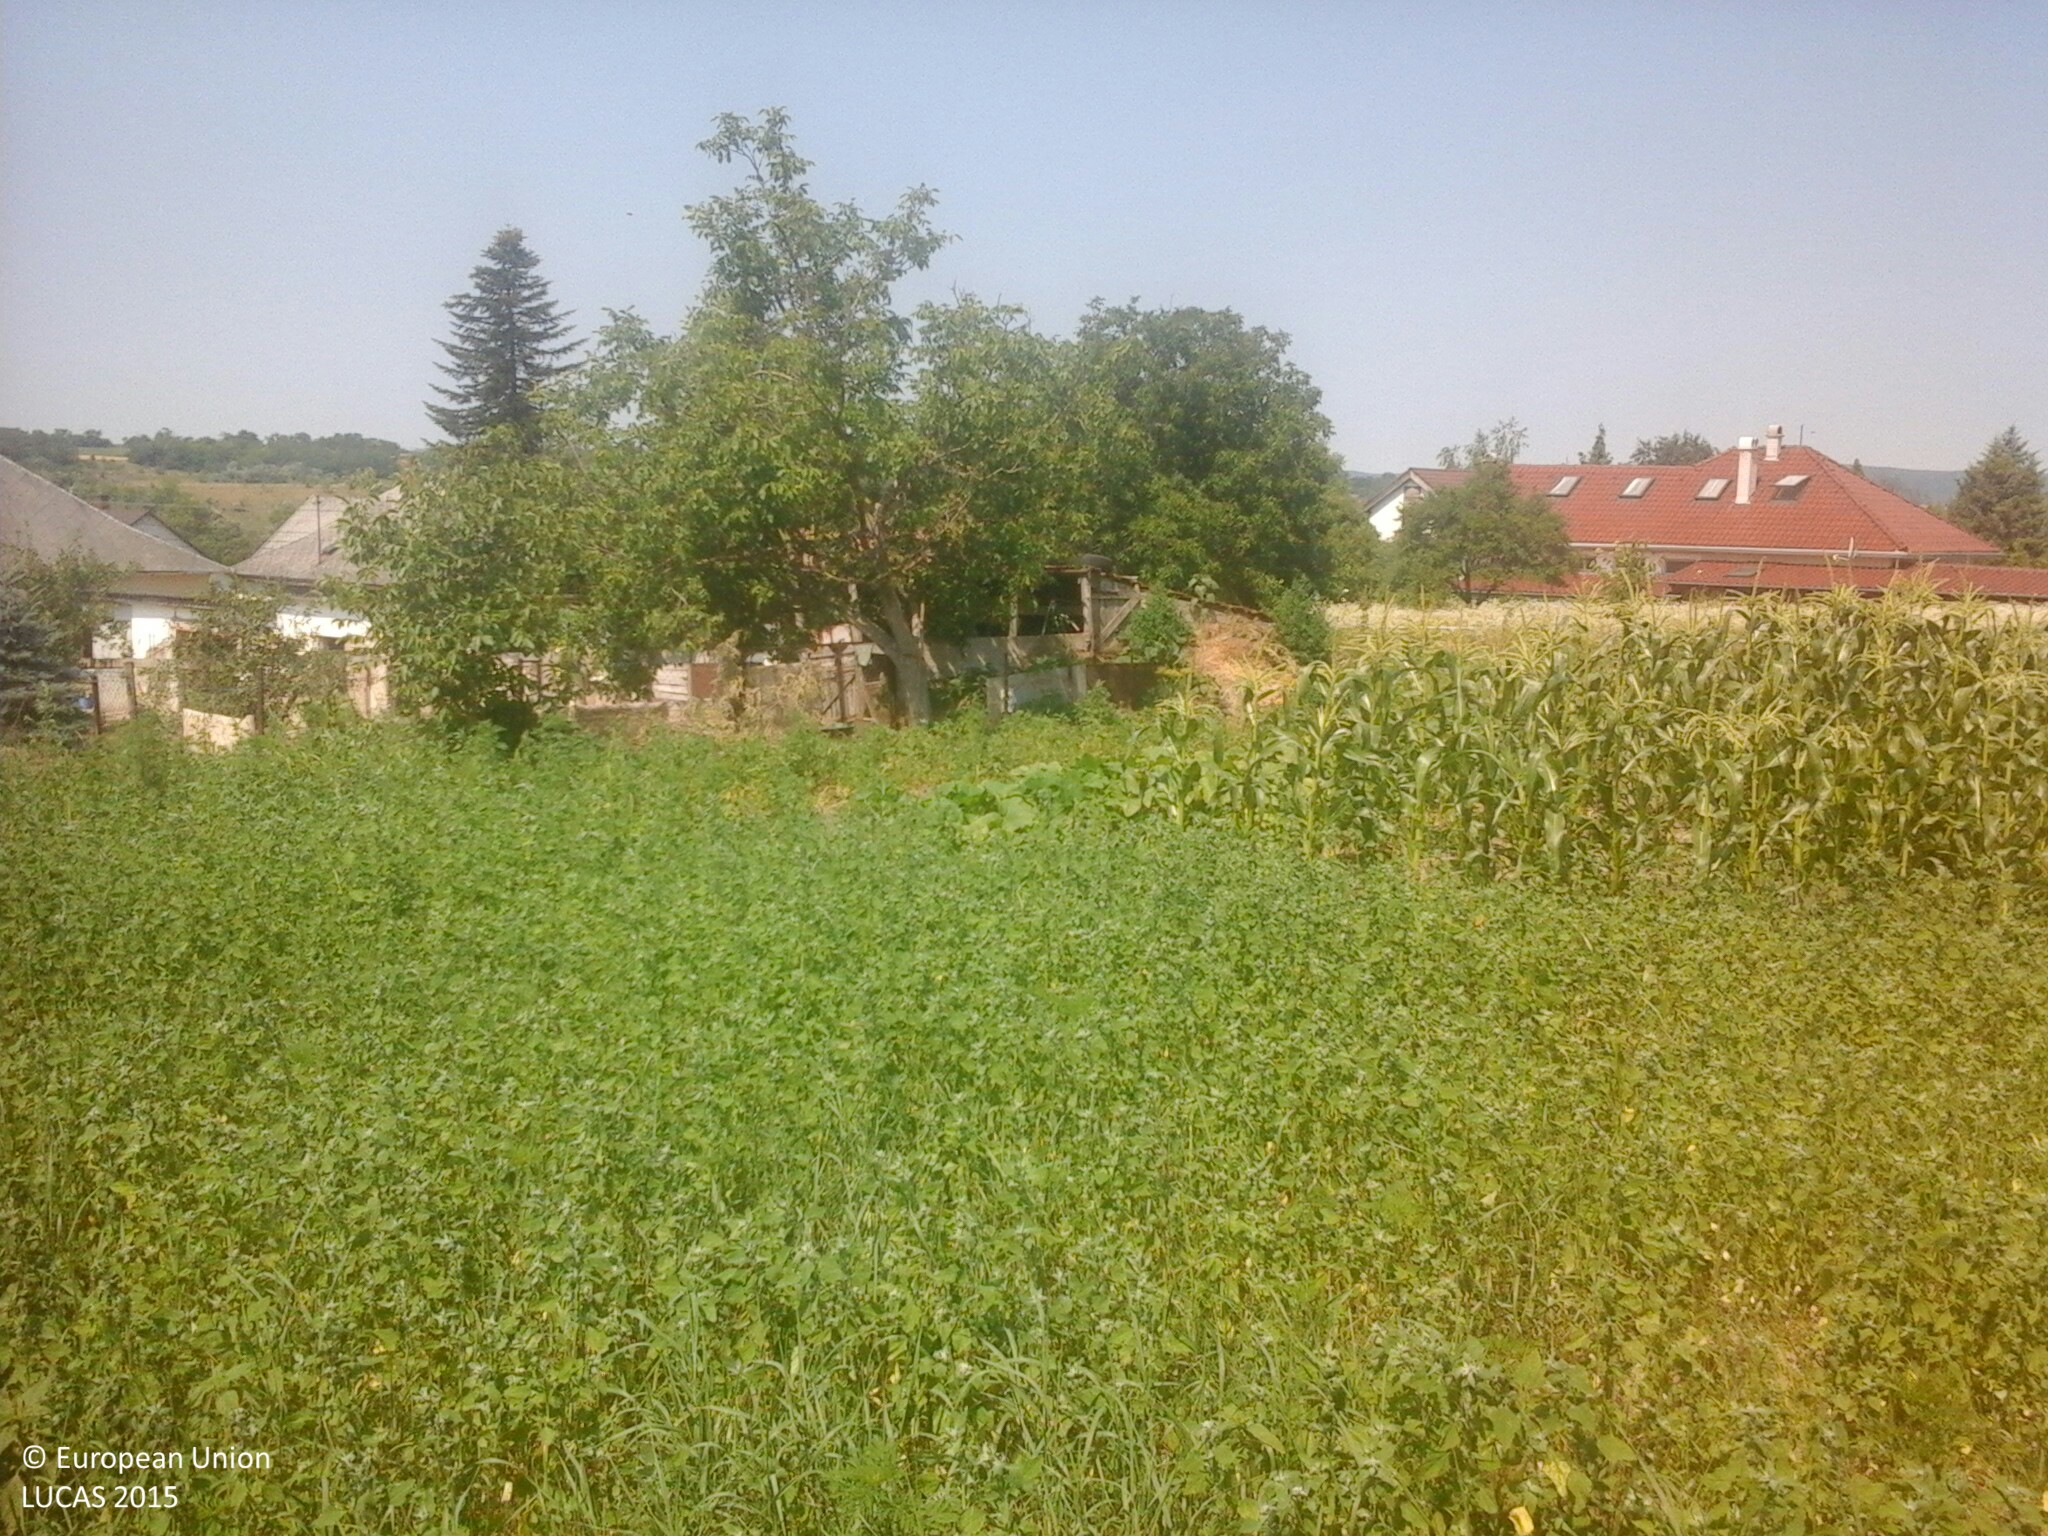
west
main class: Grassland
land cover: Spontaneously vegetated surfaces
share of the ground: > 75 %
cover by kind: herbaceous plants 100 %
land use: Agriculture (excluding fallow land and kitchen gardens)
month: July
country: HU
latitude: 47.4351
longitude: 18.5928
